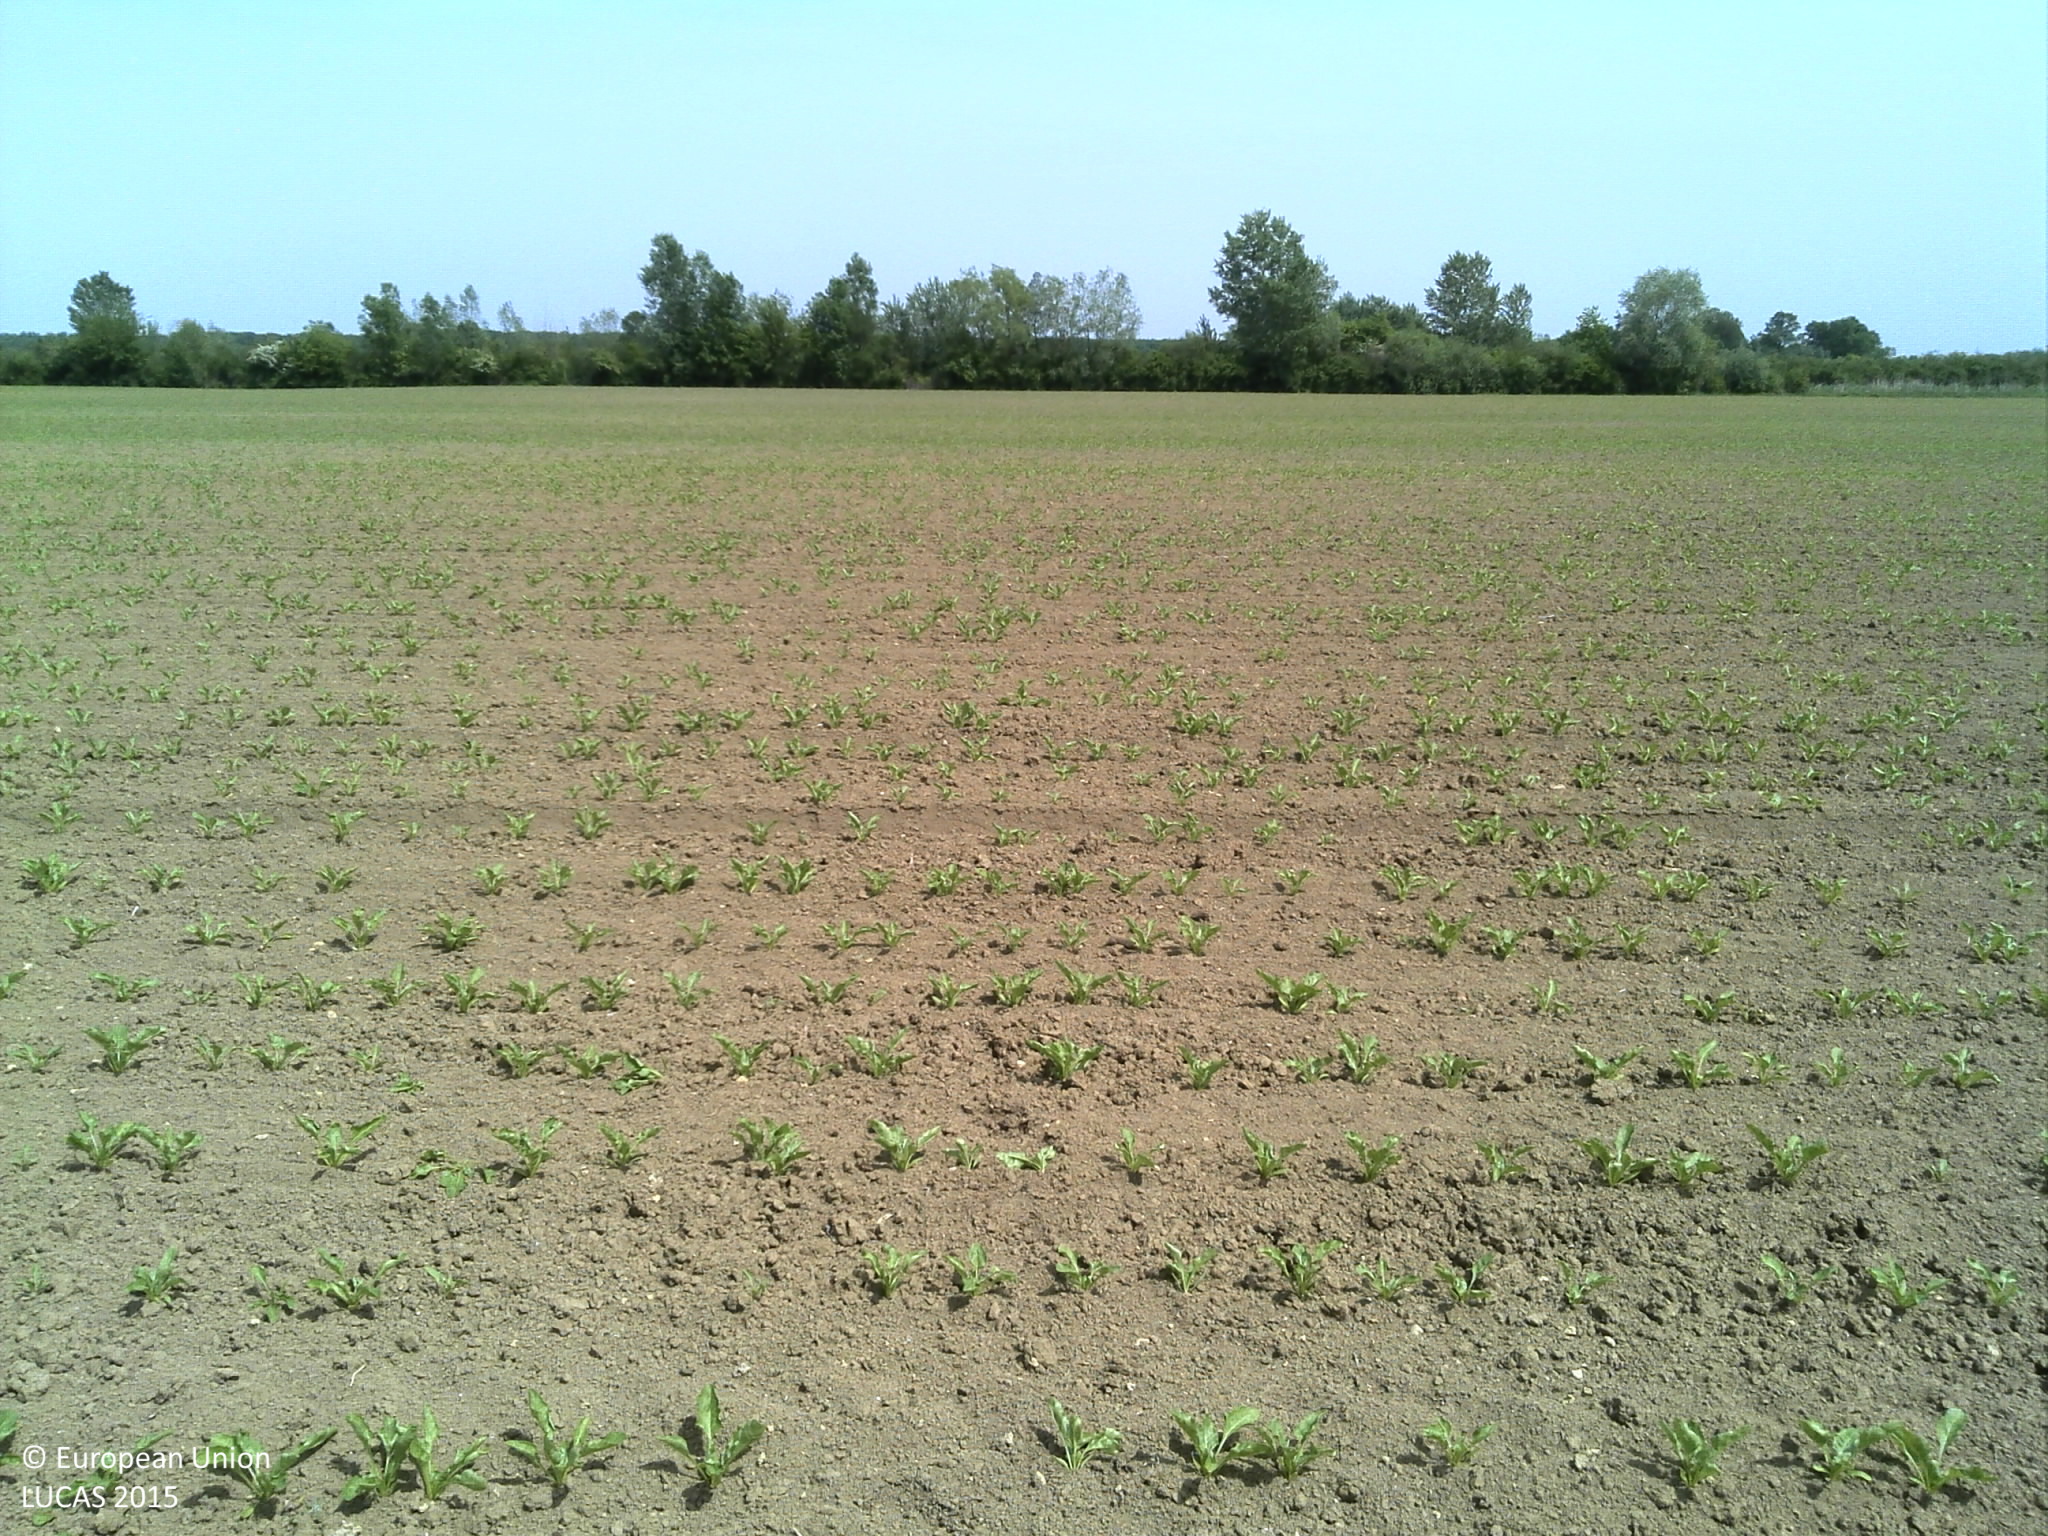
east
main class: Cropland
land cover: Sugar beet
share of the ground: < 10 %
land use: Agriculture (excluding fallow land and kitchen gardens)
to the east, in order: Sugar beet; Ditches and canals; Abandoned hedges; Tracks; Ditches and canals; Tracks; Common wheat
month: May
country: HR
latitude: 45.1977
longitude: 18.4958
